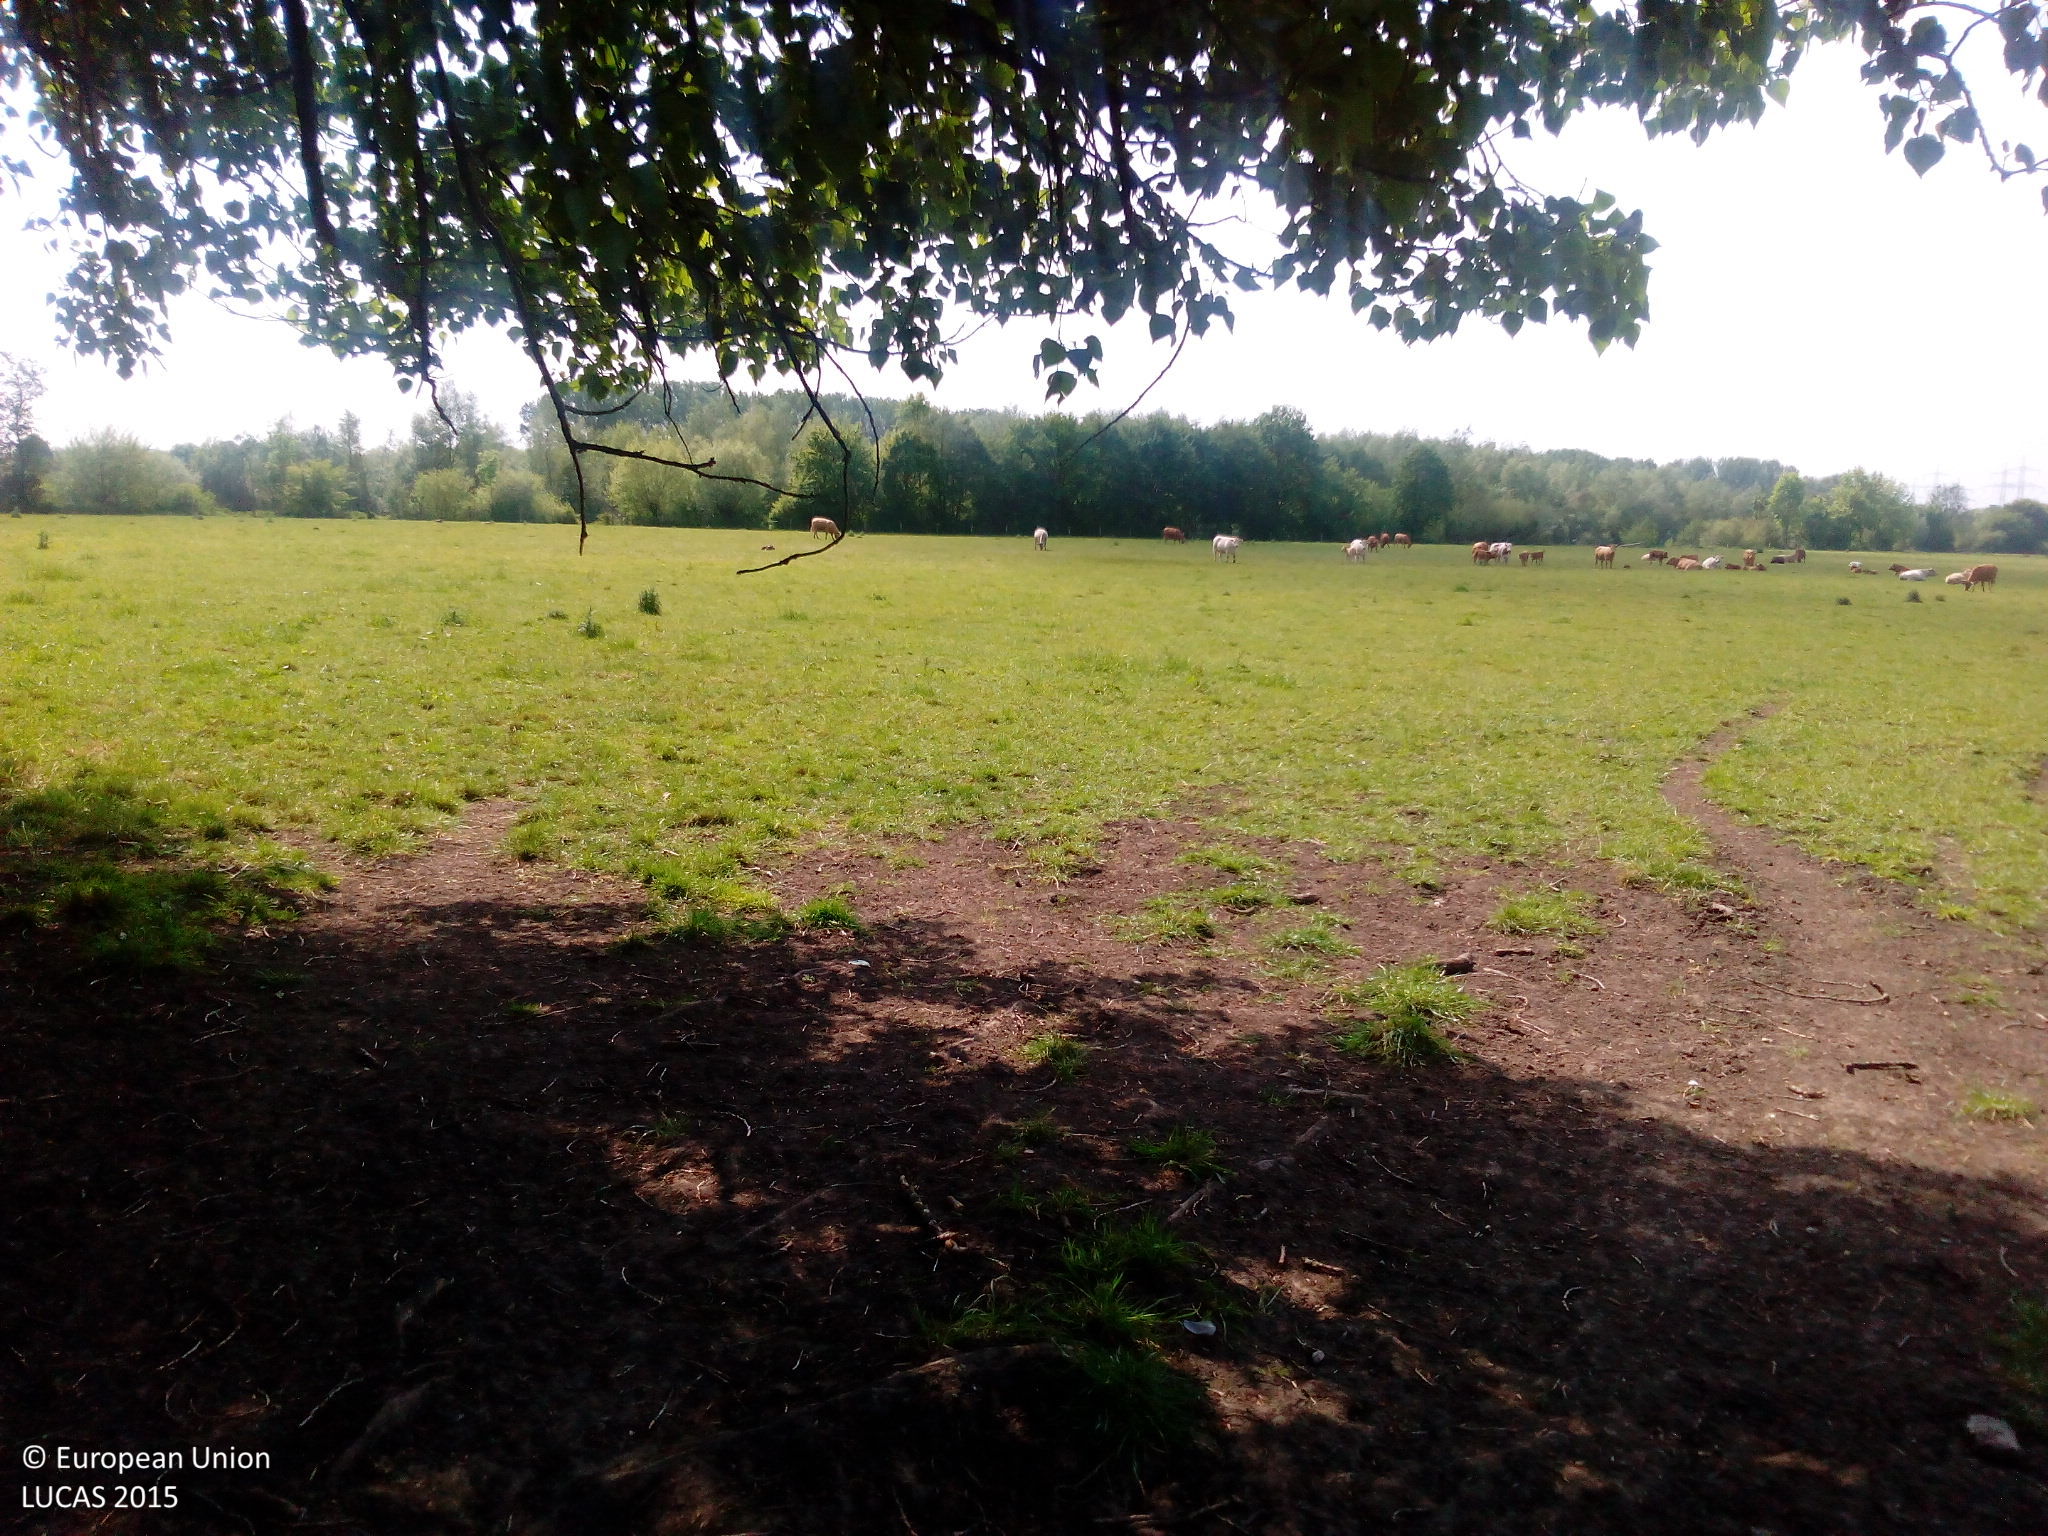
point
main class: Grassland
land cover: Grassland without tree/shrub cover
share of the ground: > 75 %
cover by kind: herbaceous plants 100 %
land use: Agriculture (excluding fallow land and kitchen gardens)
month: May
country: DE
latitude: 51.6947
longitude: 7.9605
